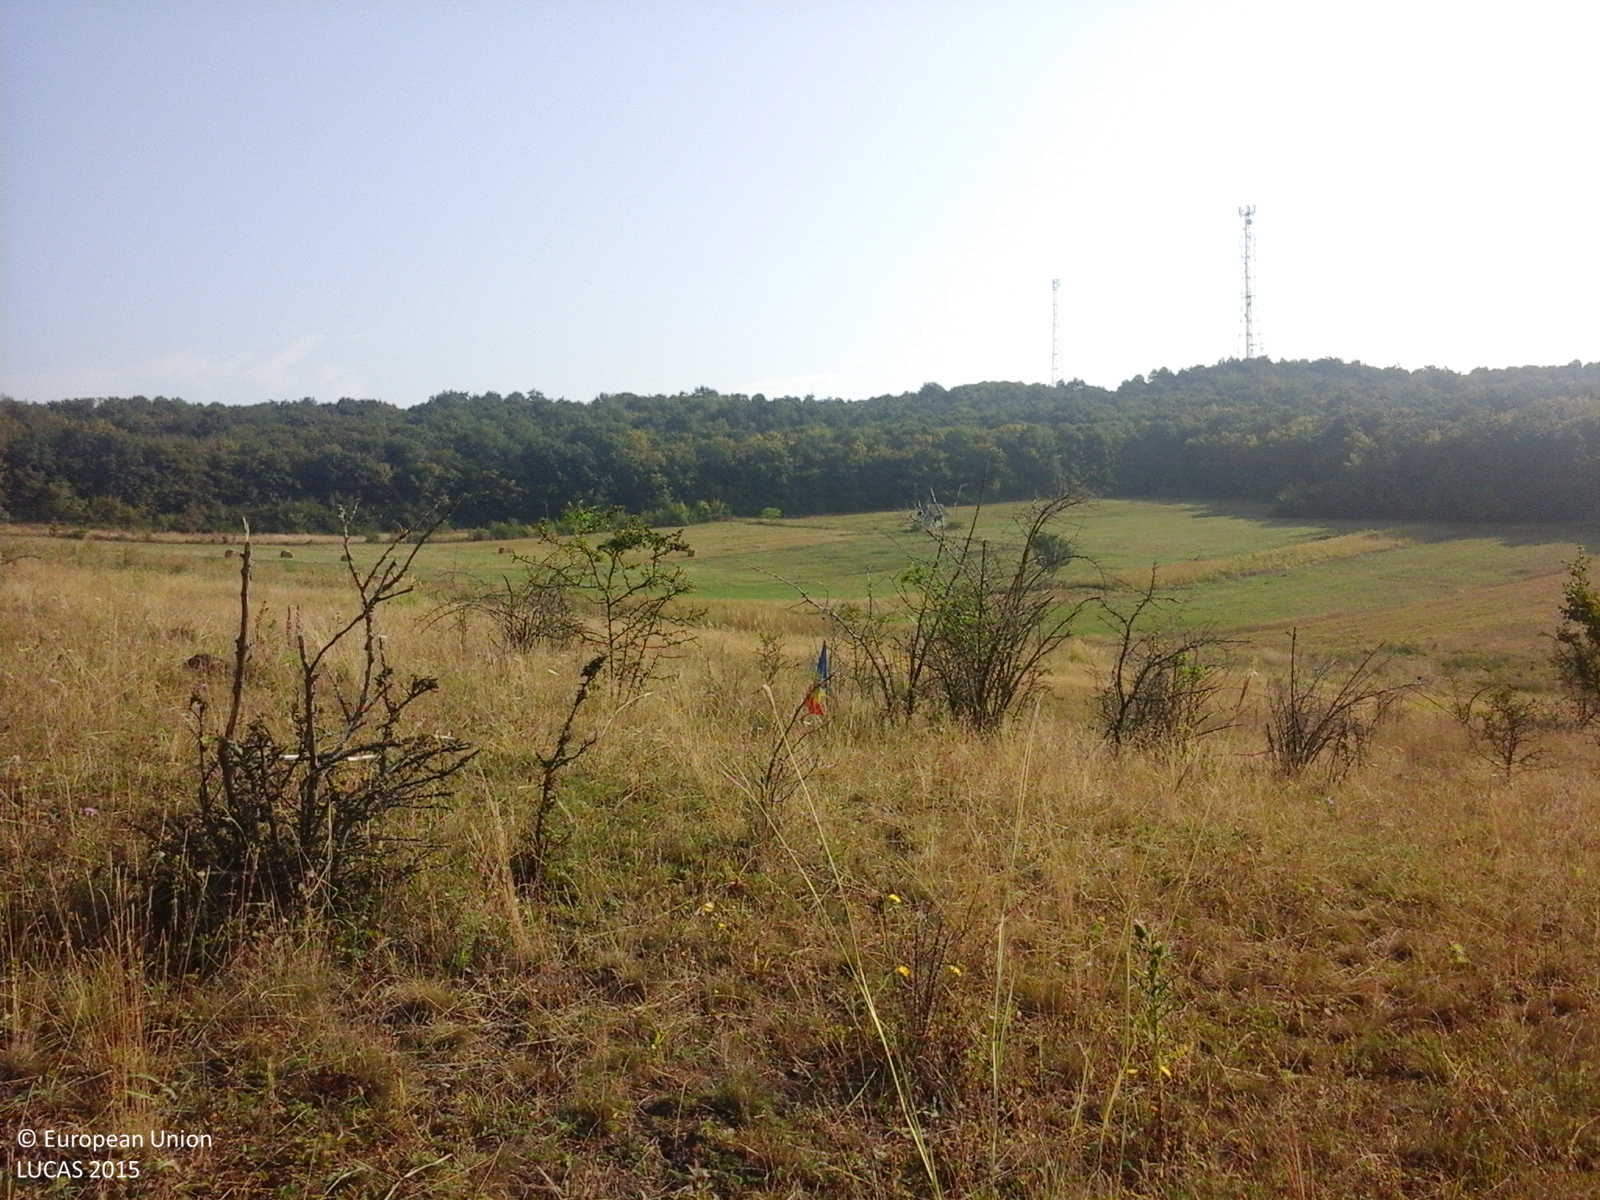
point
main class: Grassland
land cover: Grassland with sparse tree/shrub cover
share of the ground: > 75 %
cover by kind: herbaceous plants 95 %, broadleaved forest trees 5 %
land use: Fallow land
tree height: < 5 m
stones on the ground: < 10 %
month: September
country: RO
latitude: 47.1935
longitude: 24.3024
